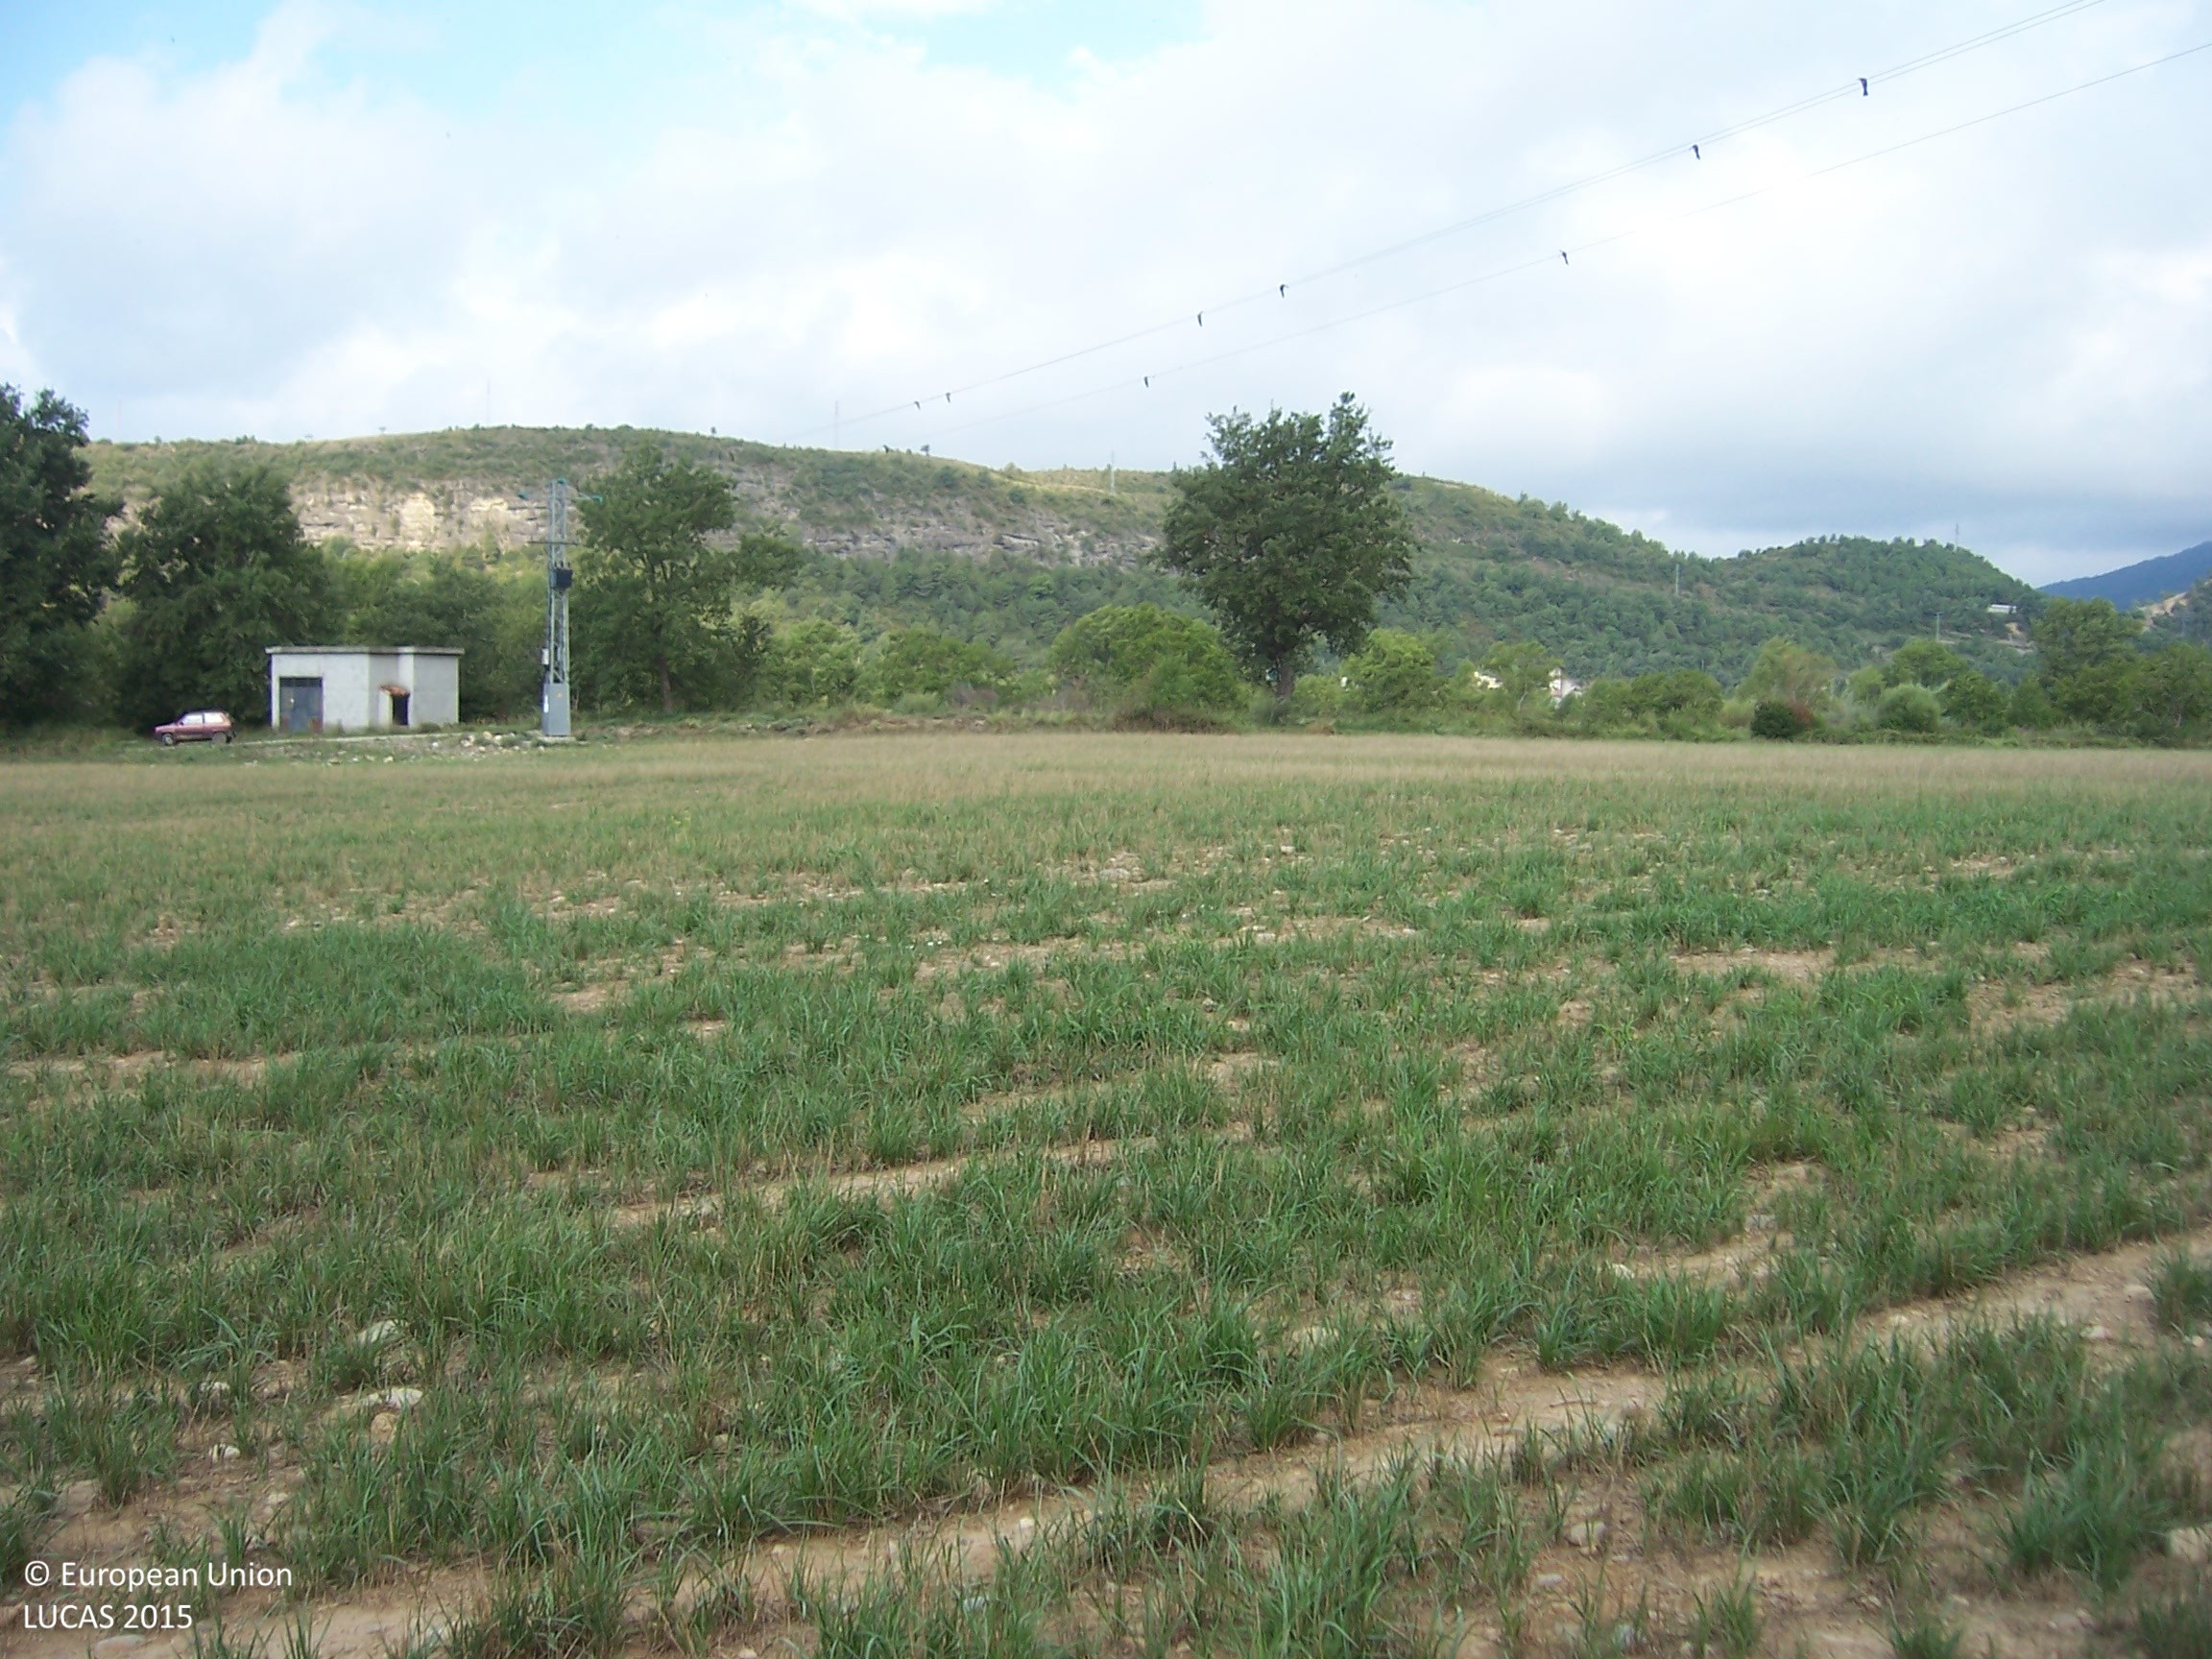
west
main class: Grassland
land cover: Spontaneously vegetated surfaces
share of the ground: > 75 %
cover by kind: herbaceous plants 60 %, unconsolidated bare surface 40 %
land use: Fallow land
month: August
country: ES
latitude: 42.4269
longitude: 0.1459
